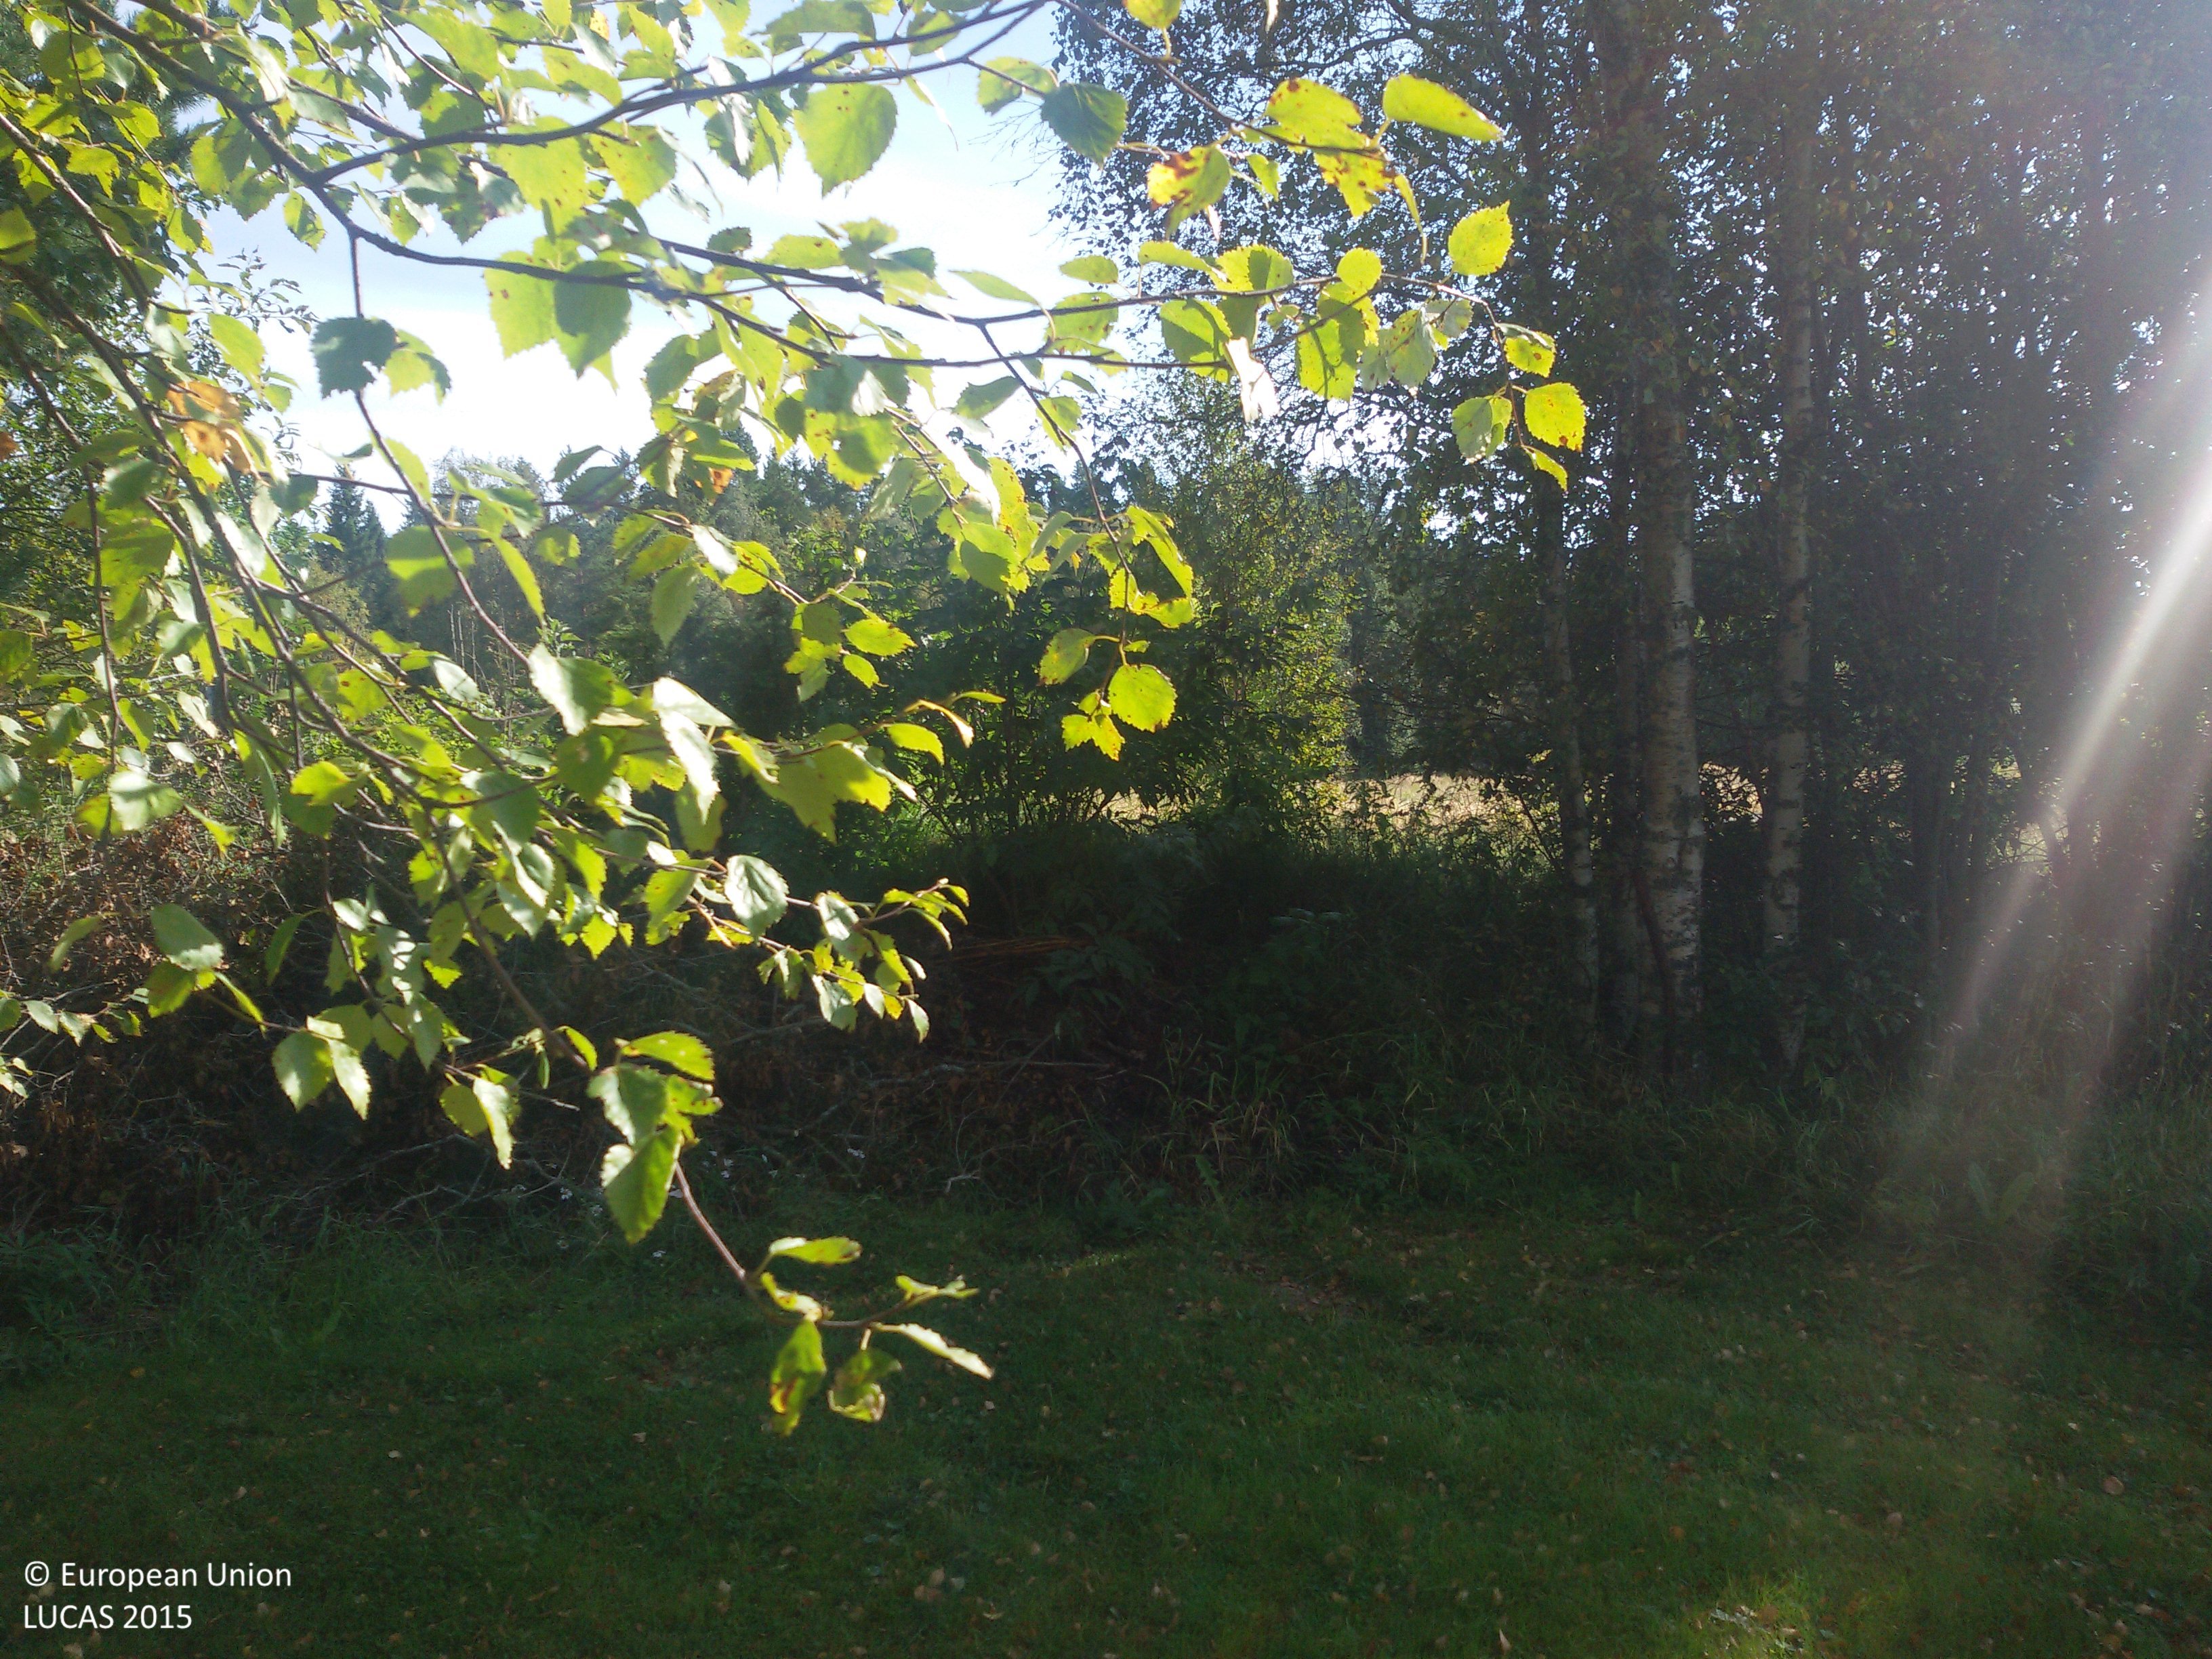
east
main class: Grassland
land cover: Grassland without tree/shrub cover
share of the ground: > 75 %
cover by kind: herbaceous plants 100 %
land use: Agriculture (excluding fallow land and kitchen gardens)
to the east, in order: Grassland without tree/shrub cover; Abandoned hedges; Barley; Spruce dominated mixed woodland; Spruce dominated coniferous woodland; Tracks; Spruce dominated coniferous woodland; Rivers and streams; Spruce dominated coniferous woodland
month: September
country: SE
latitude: 60.9226
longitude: 14.9853
